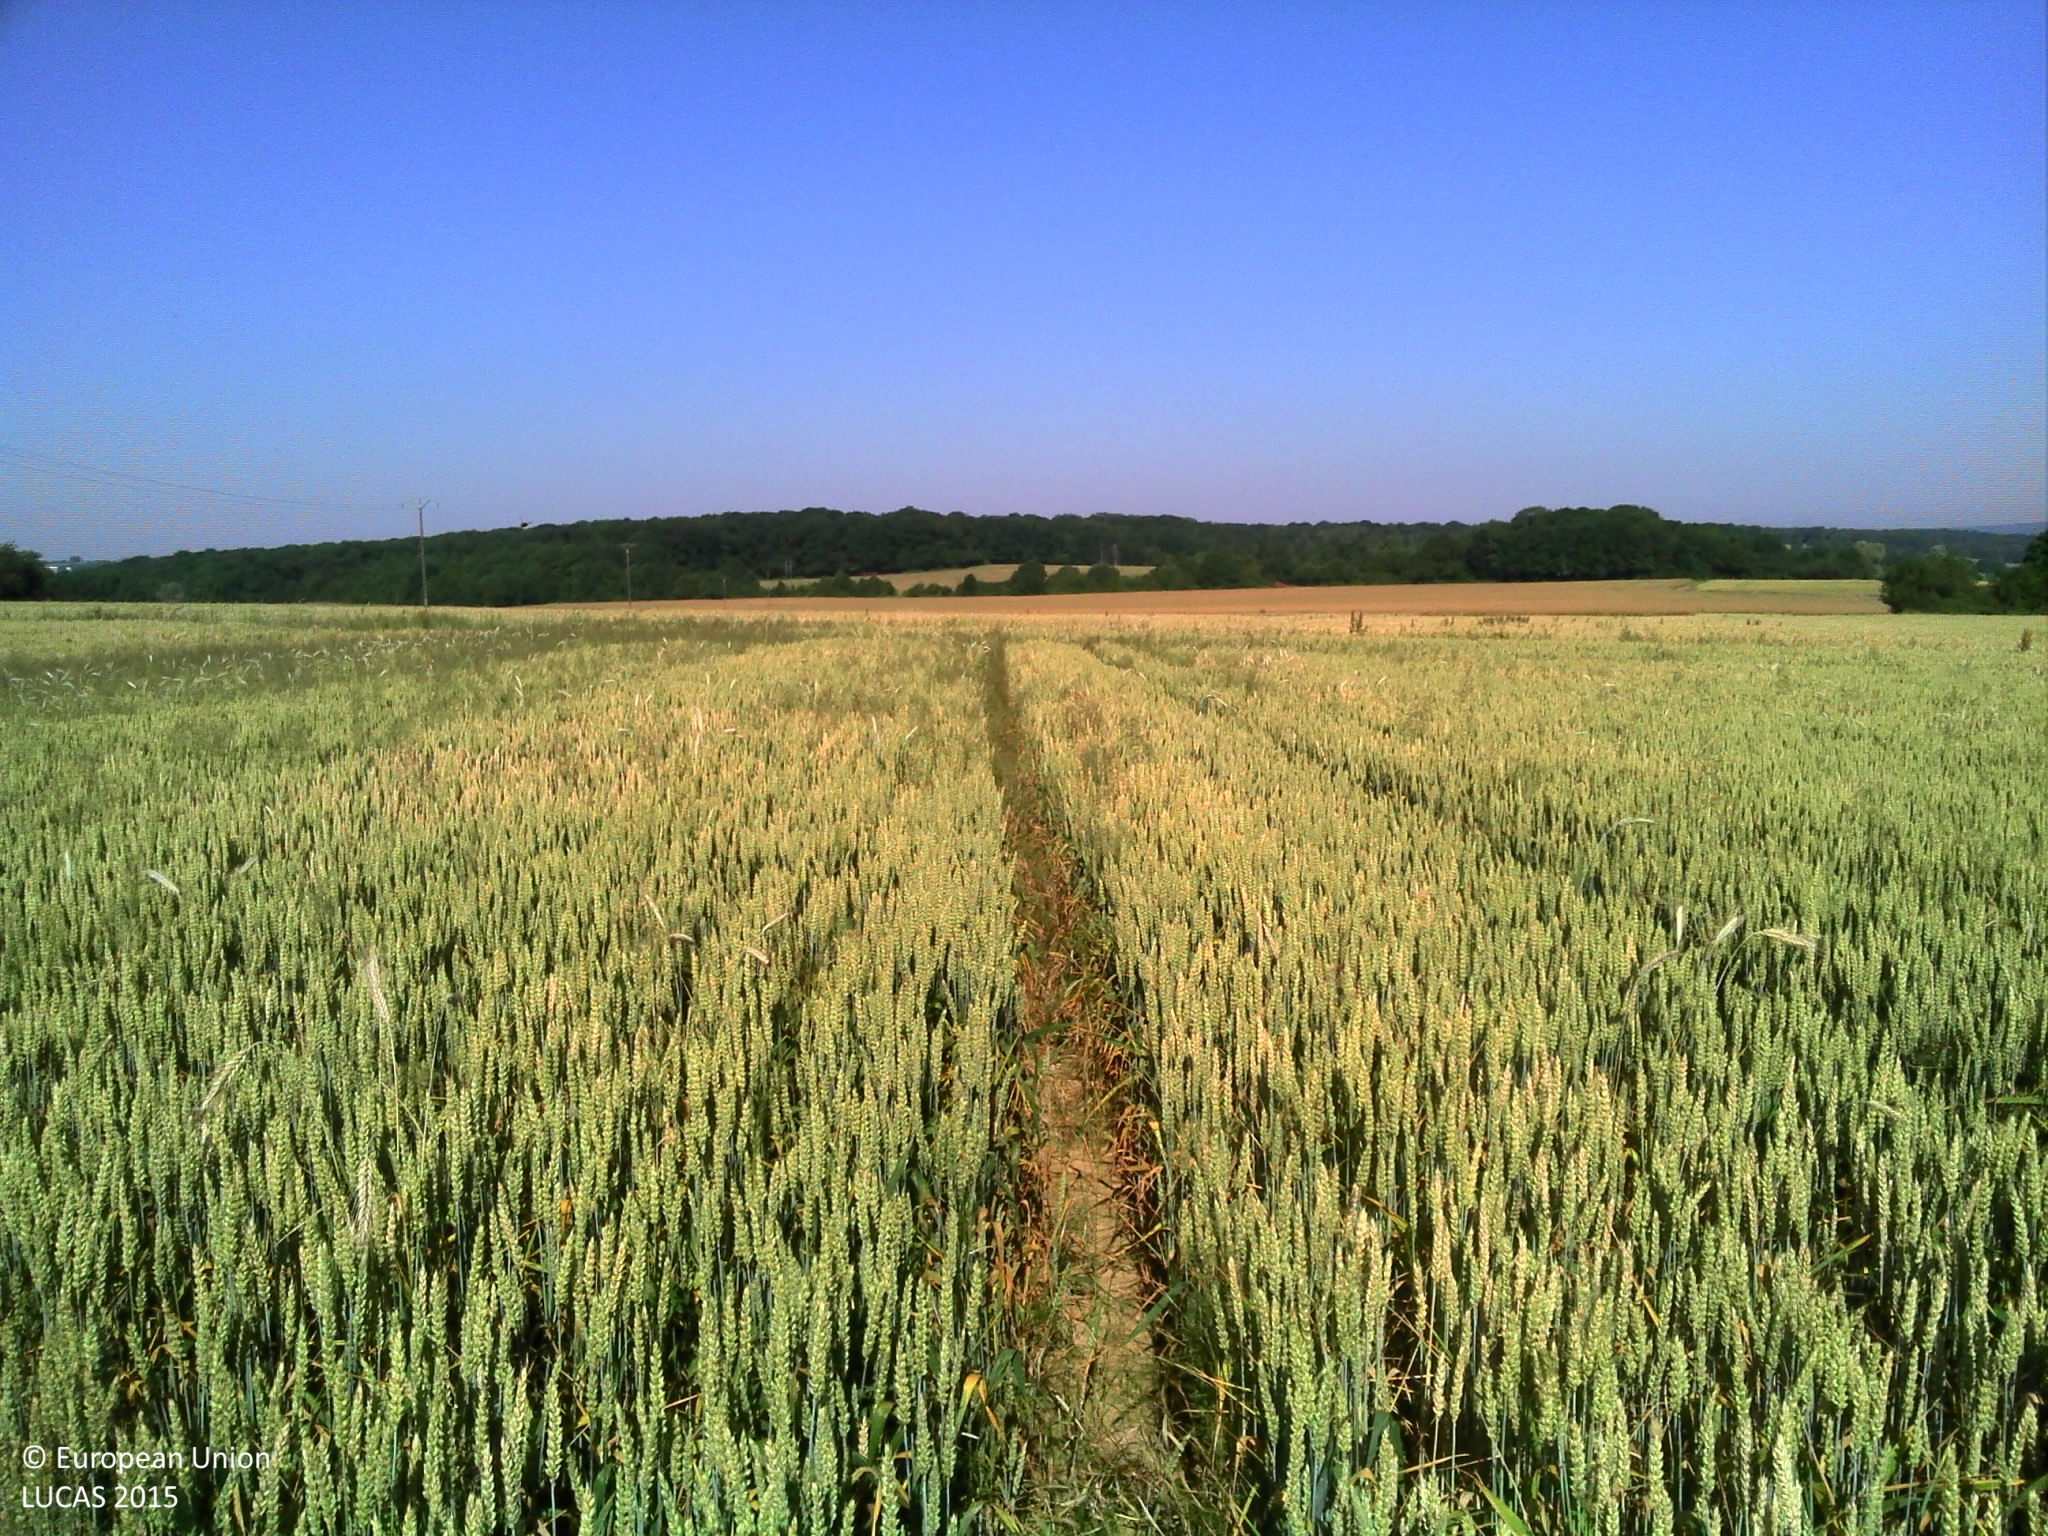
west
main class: Cropland
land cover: Common wheat
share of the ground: > 75 %
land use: Agriculture (excluding fallow land and kitchen gardens)
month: July
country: FR
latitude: 48.5739
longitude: 6.2459
